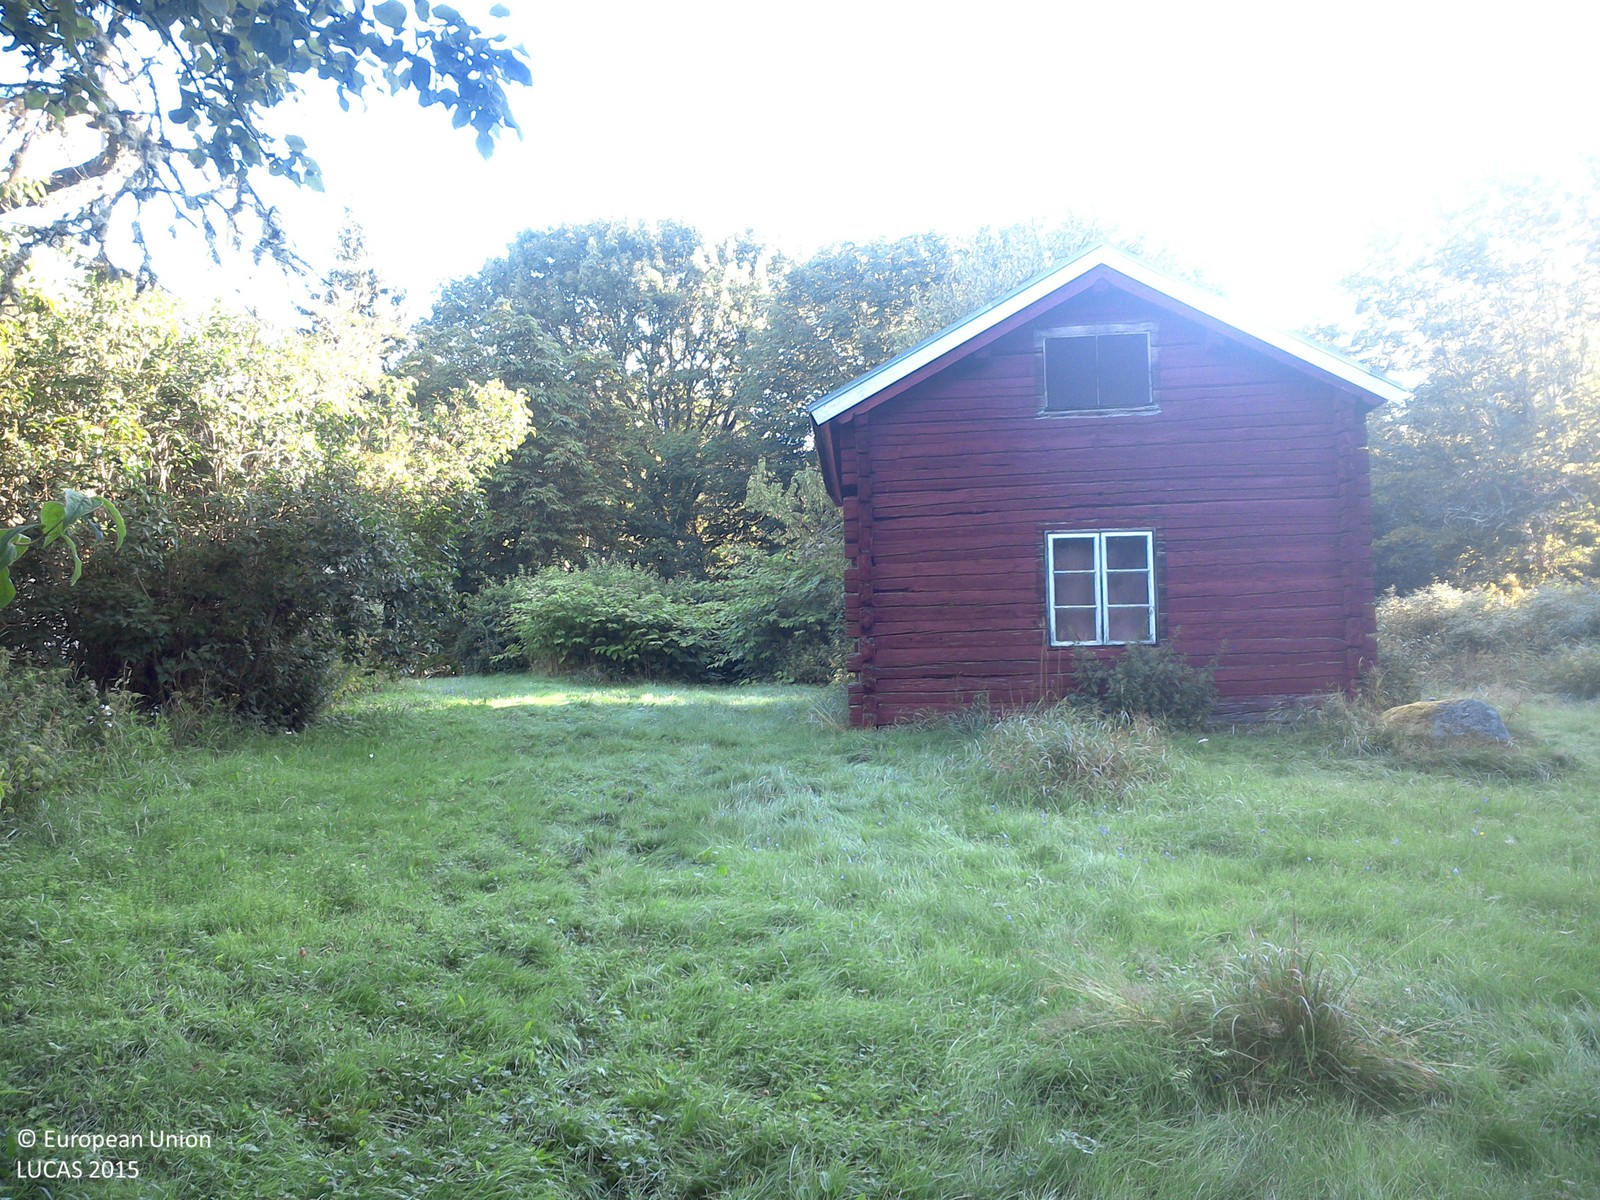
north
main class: Grassland
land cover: Grassland with sparse tree/shrub cover
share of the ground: > 75 %
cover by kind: herbaceous plants 95 %, broadleaved forest trees 5 %
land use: Residential
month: August
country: SE
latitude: 57.7935
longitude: 15.6655
